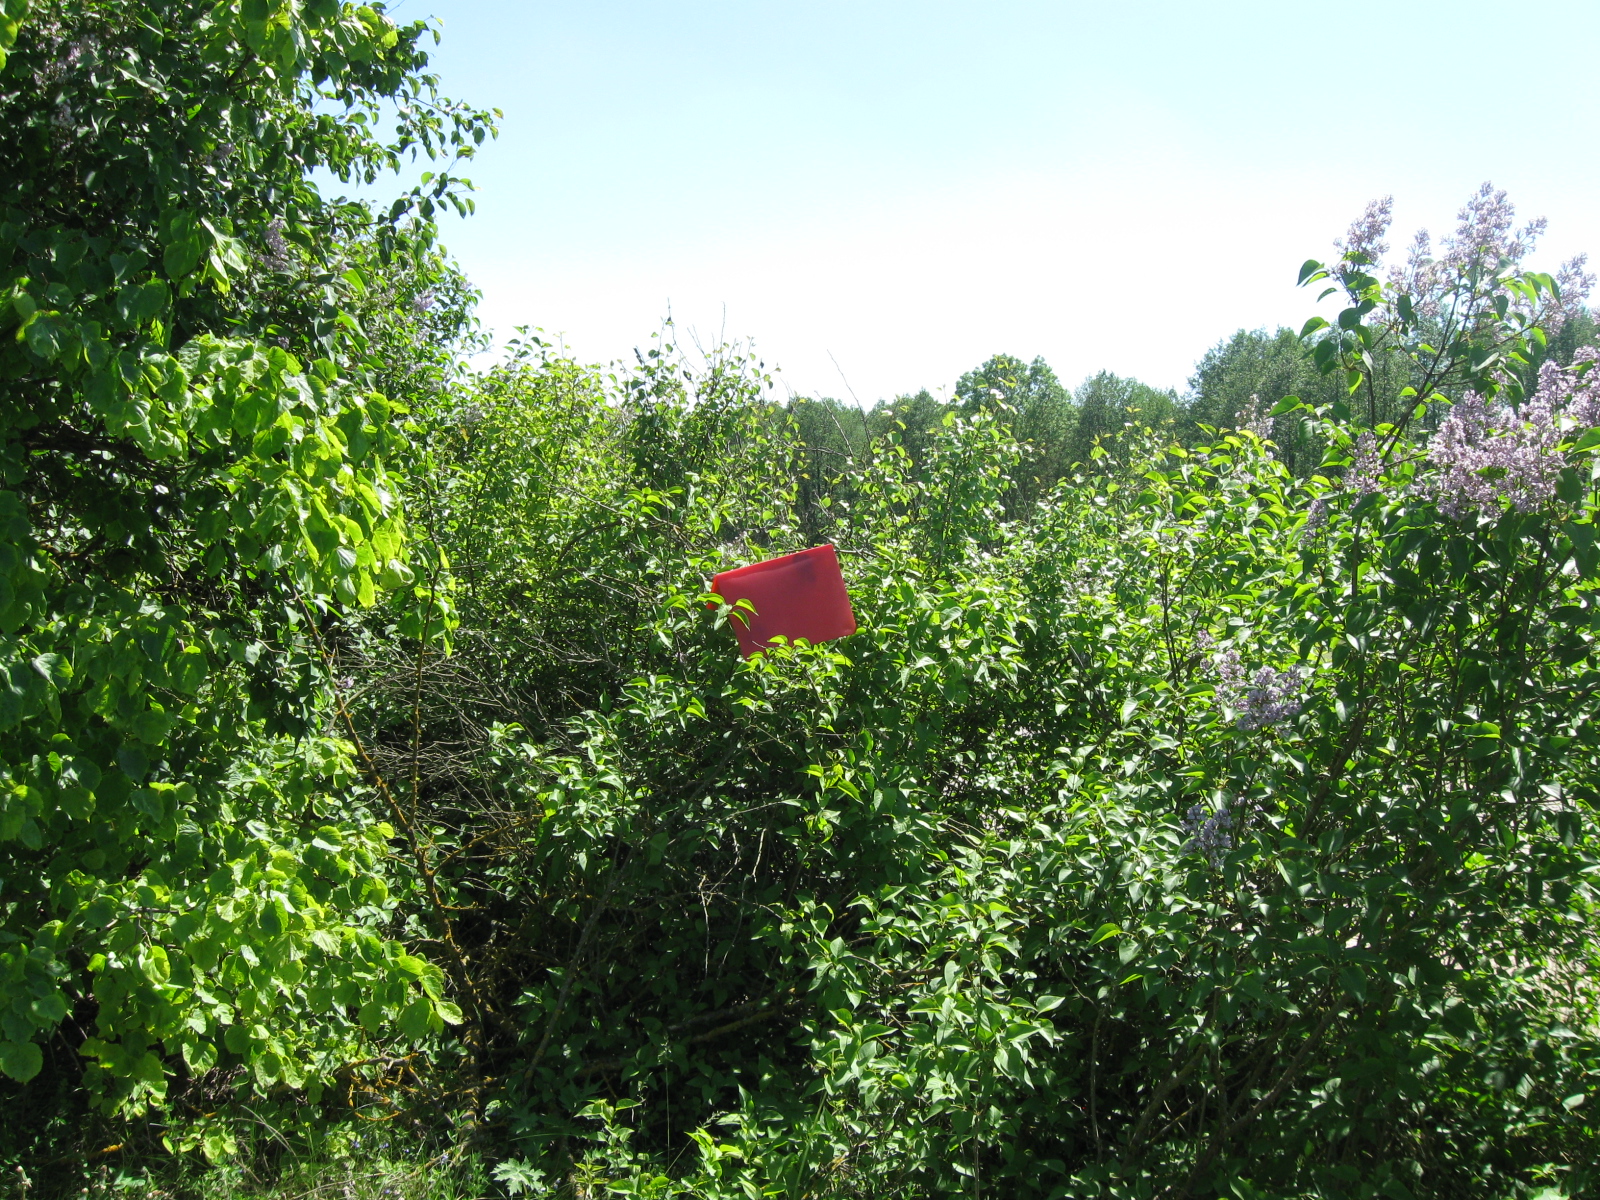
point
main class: Woodland
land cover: Broadleaved woodland
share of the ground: 25 - 50 %
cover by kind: broadleaved forest trees 45 %, herbaceous plants 40 %, shrubs 15 %
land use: Forestry
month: June
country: LT
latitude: 54.0949
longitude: 23.5547
